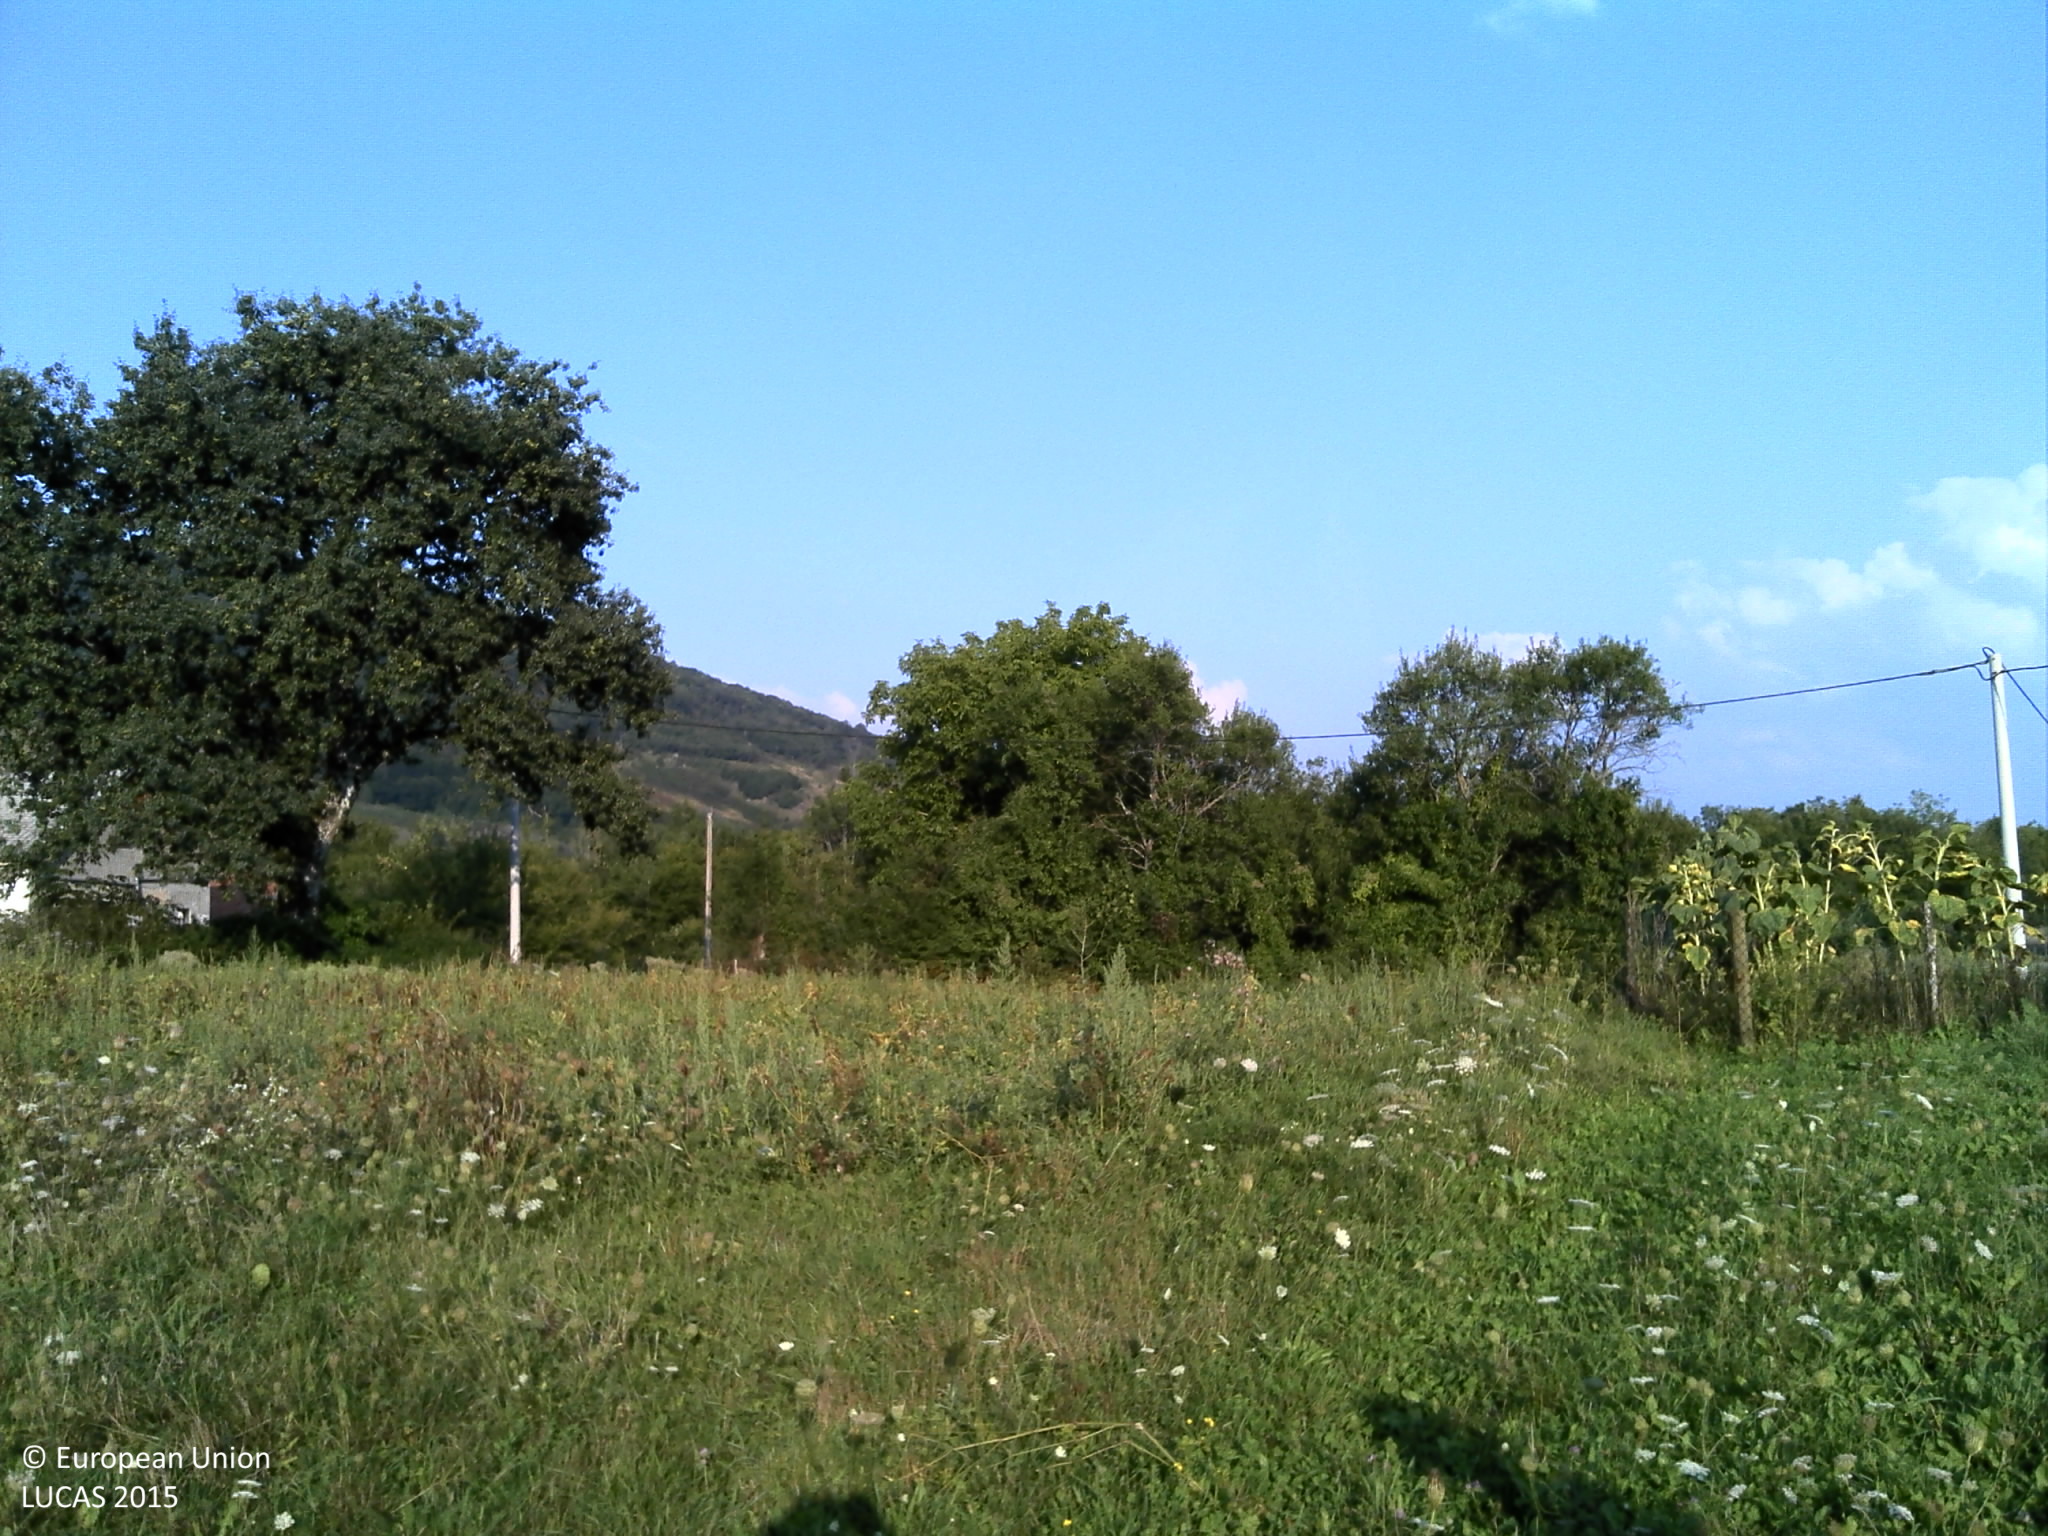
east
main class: Grassland
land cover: Grassland with sparse tree/shrub cover
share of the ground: > 75 %
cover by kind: herbaceous plants 90 %, broadleaved forest trees 5 %, shrubs 5 %
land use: Agriculture (excluding fallow land and kitchen gardens)
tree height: < 5 m
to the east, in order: Grassland with sparse tree/shrub cover; Other fresh vegetables; Electric lines; Other fresh vegetables; Grass margins; Paved roads, cycling and walking lanes; Broadleaved woodland; Shrubland with sparse tree cover; Broadleaved woodland; Grassland with sparse tree/shrub cover; Broadleaved woodland
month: August
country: HR
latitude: 45.0053
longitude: 15.0312
